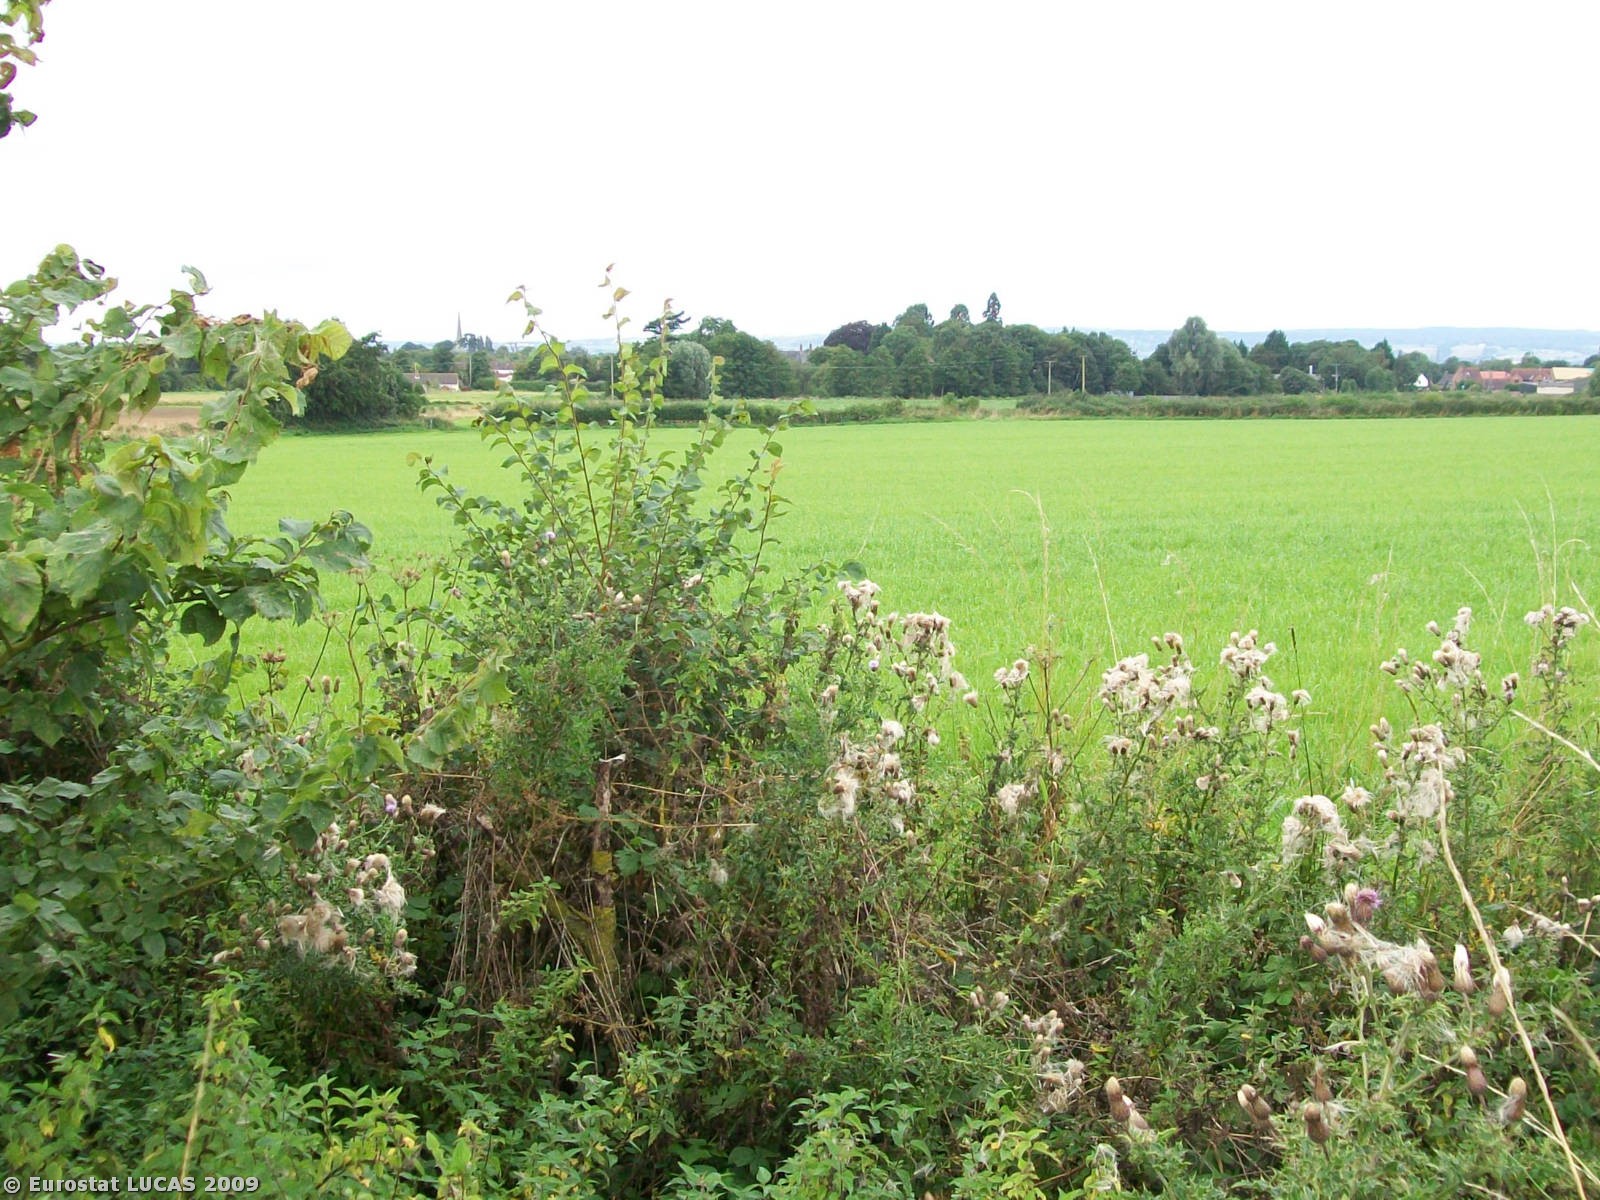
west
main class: Cropland
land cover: Temporary grasslands
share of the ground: > 75 %
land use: Agriculture (excluding fallow land and kitchen gardens)
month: August
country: GB
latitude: 51.7289
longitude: -2.3562
